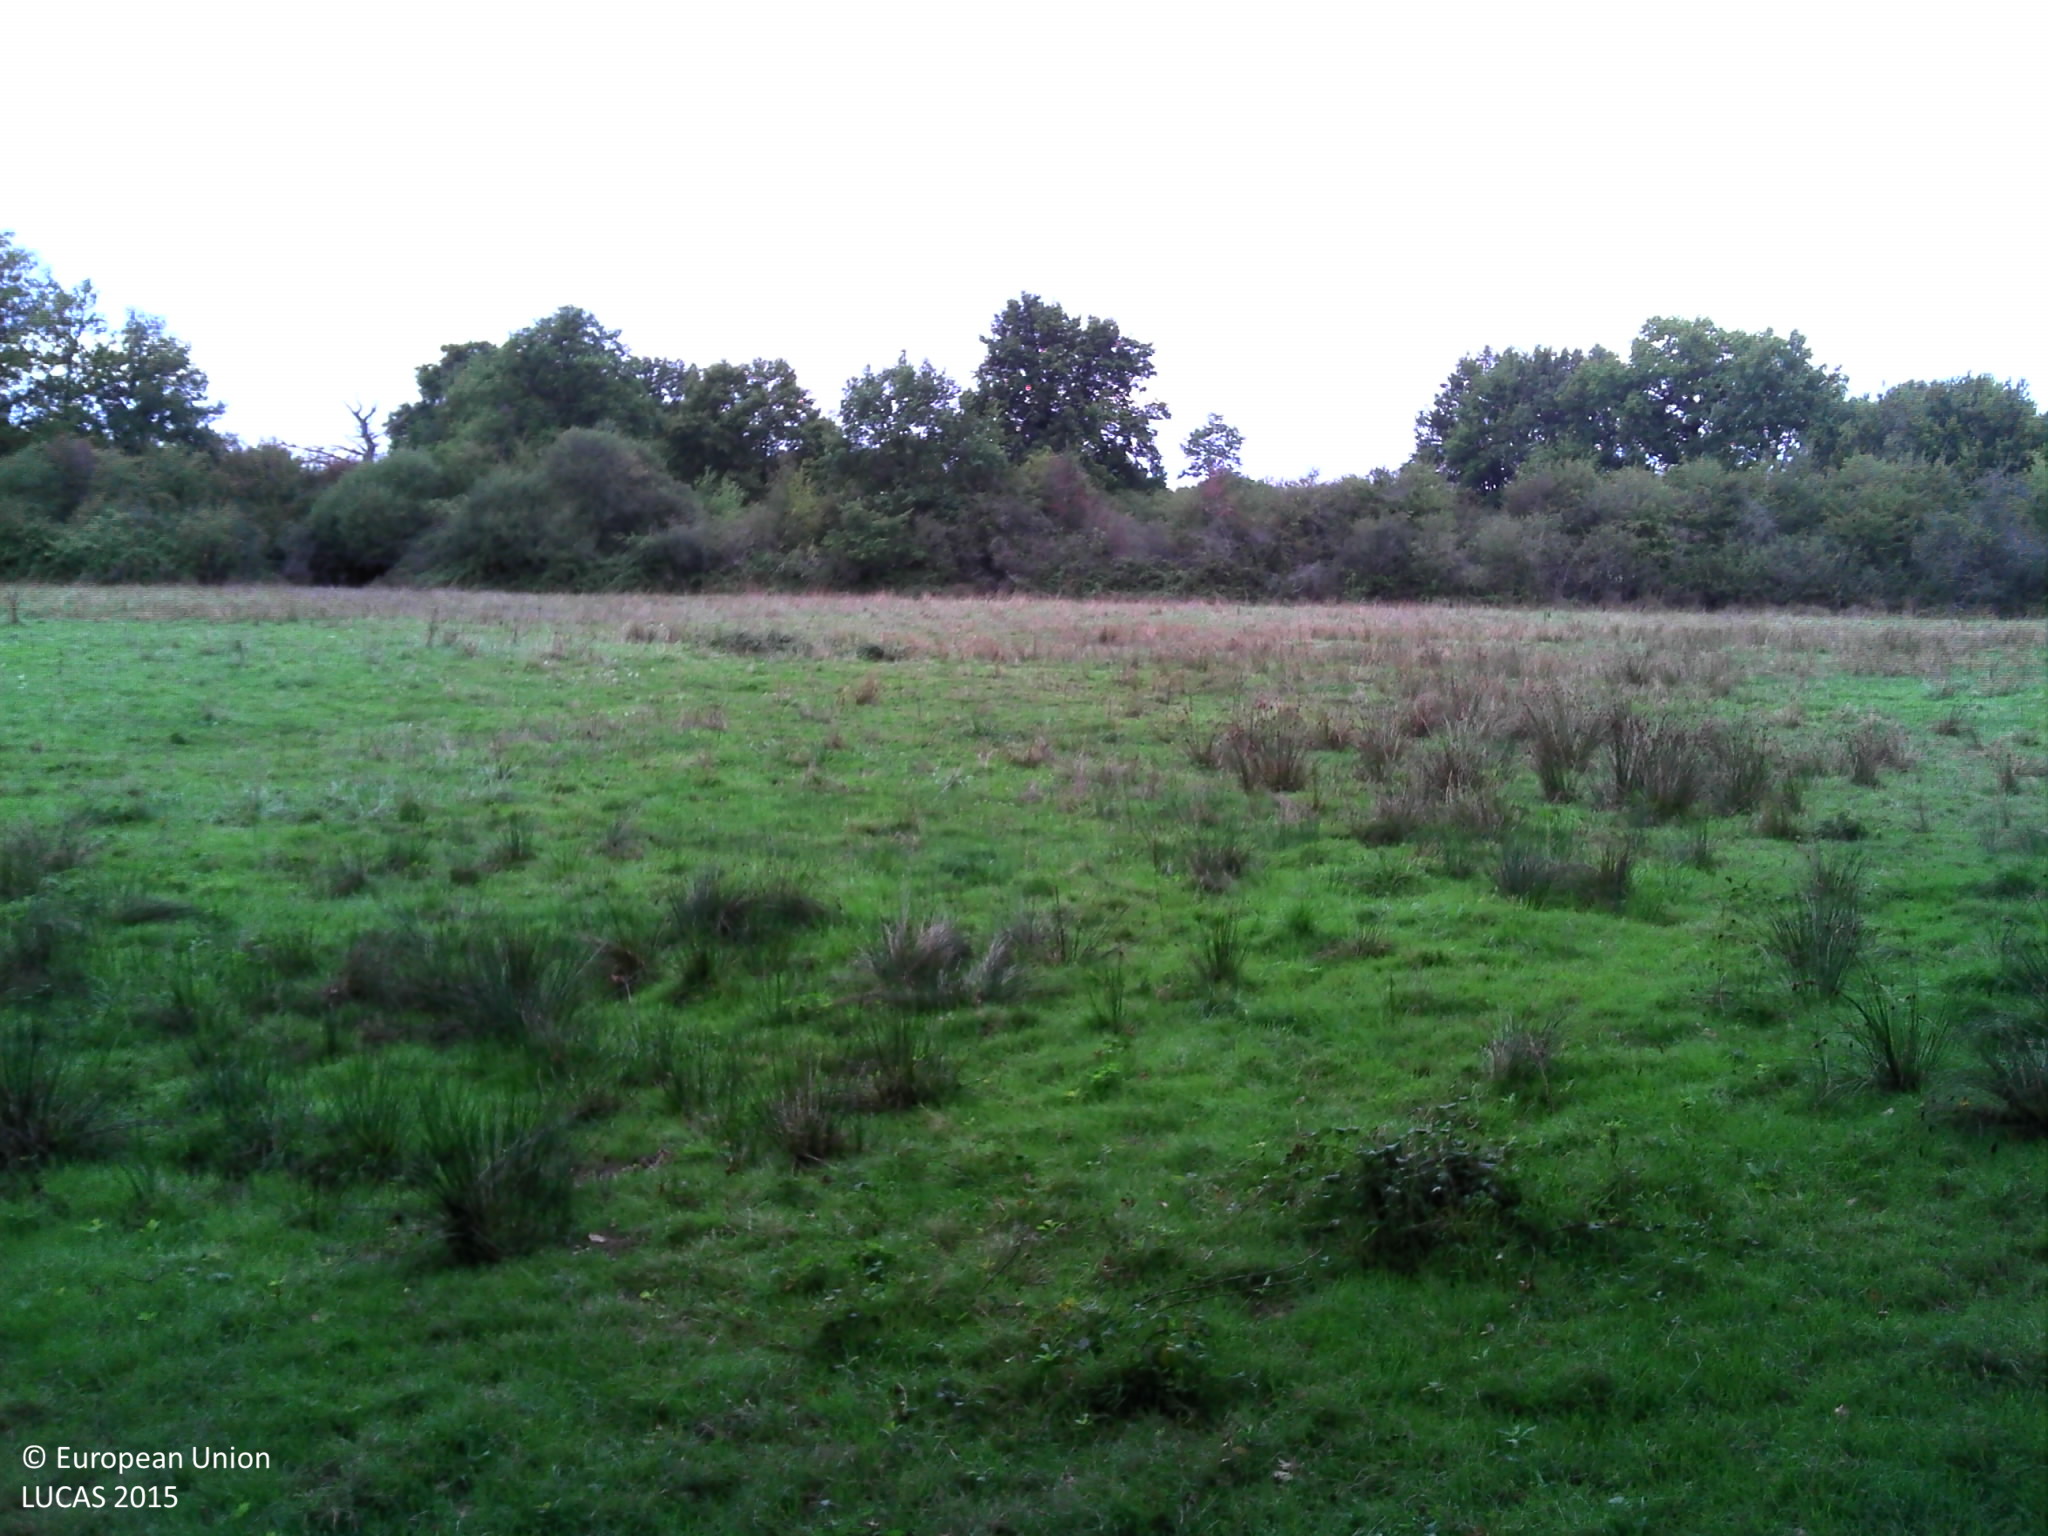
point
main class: Grassland
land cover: Grassland without tree/shrub cover
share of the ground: > 75 %
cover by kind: herbaceous plants 100 %
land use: Agriculture (excluding fallow land and kitchen gardens)
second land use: Amenities, museums, leisure
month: September
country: FR
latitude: 46.4924
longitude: 1.1673
